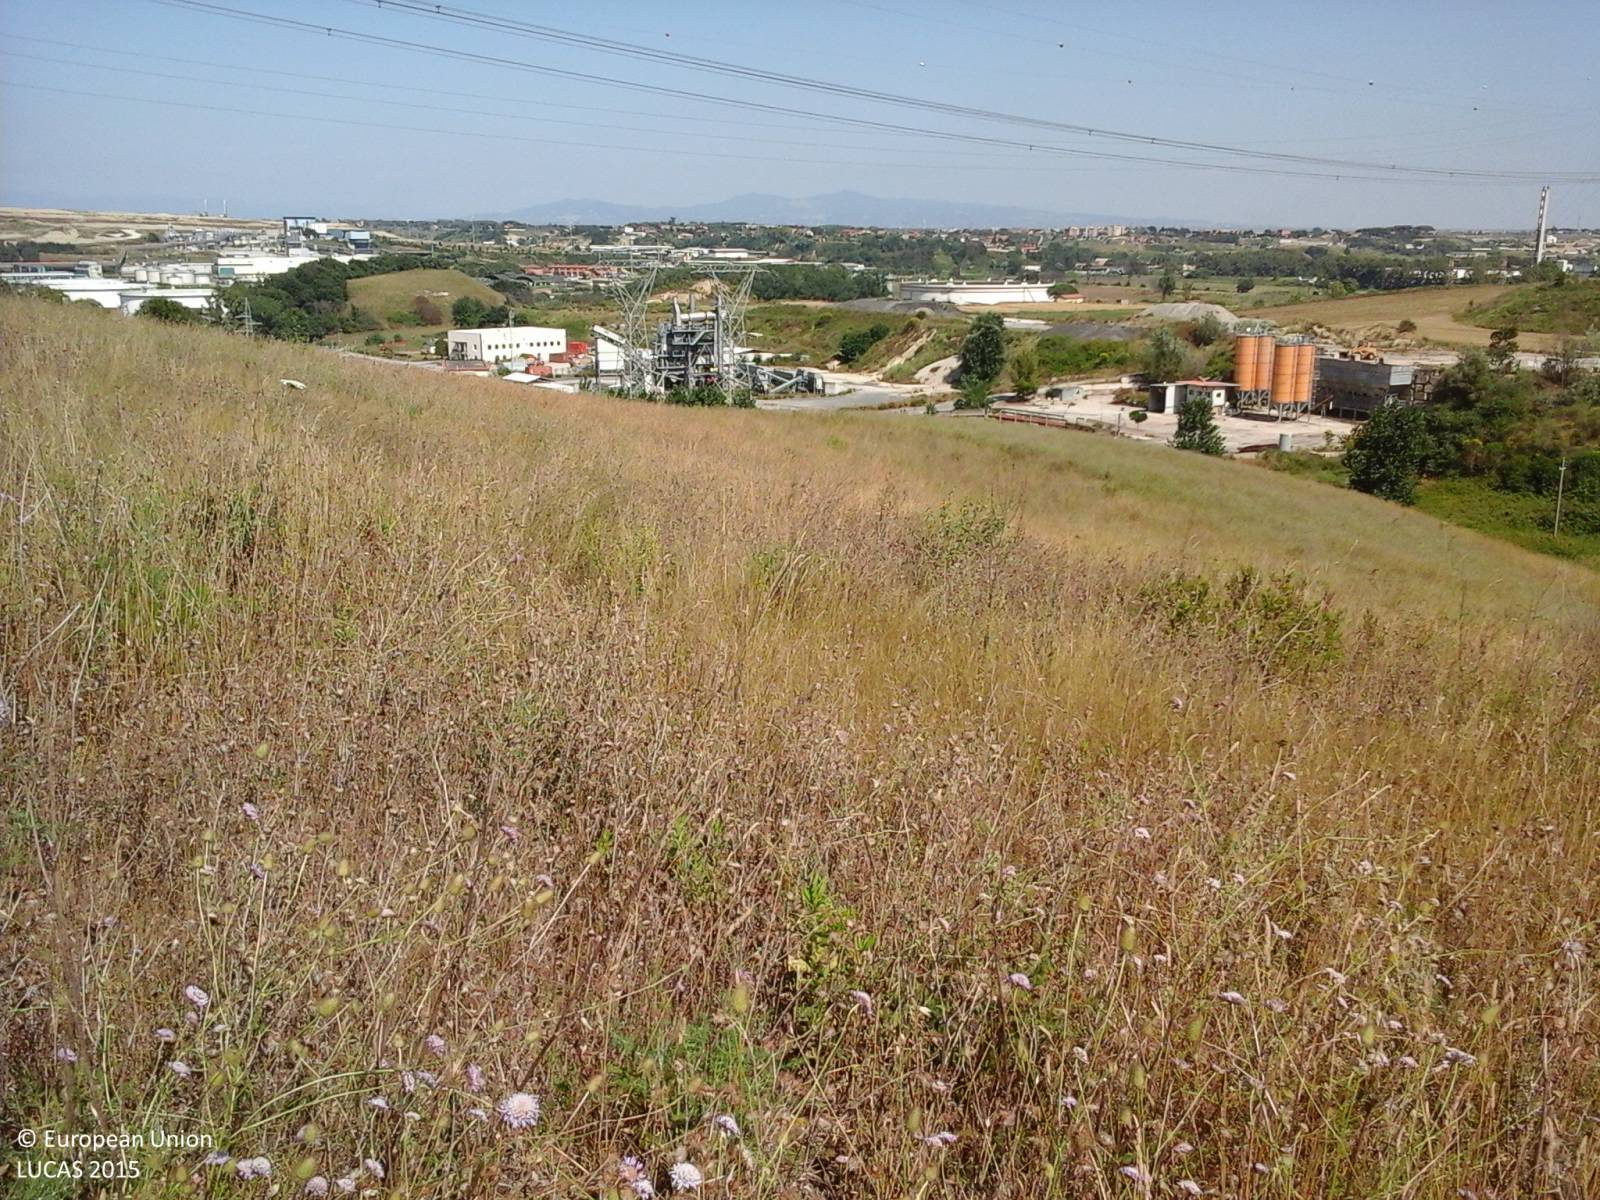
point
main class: Grassland
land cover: Grassland without tree/shrub cover
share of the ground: > 75 %
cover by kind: herbaceous plants 100 %
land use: Semi-natural and natural areas not in use
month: June
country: IT
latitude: 41.8504
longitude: 12.3158
